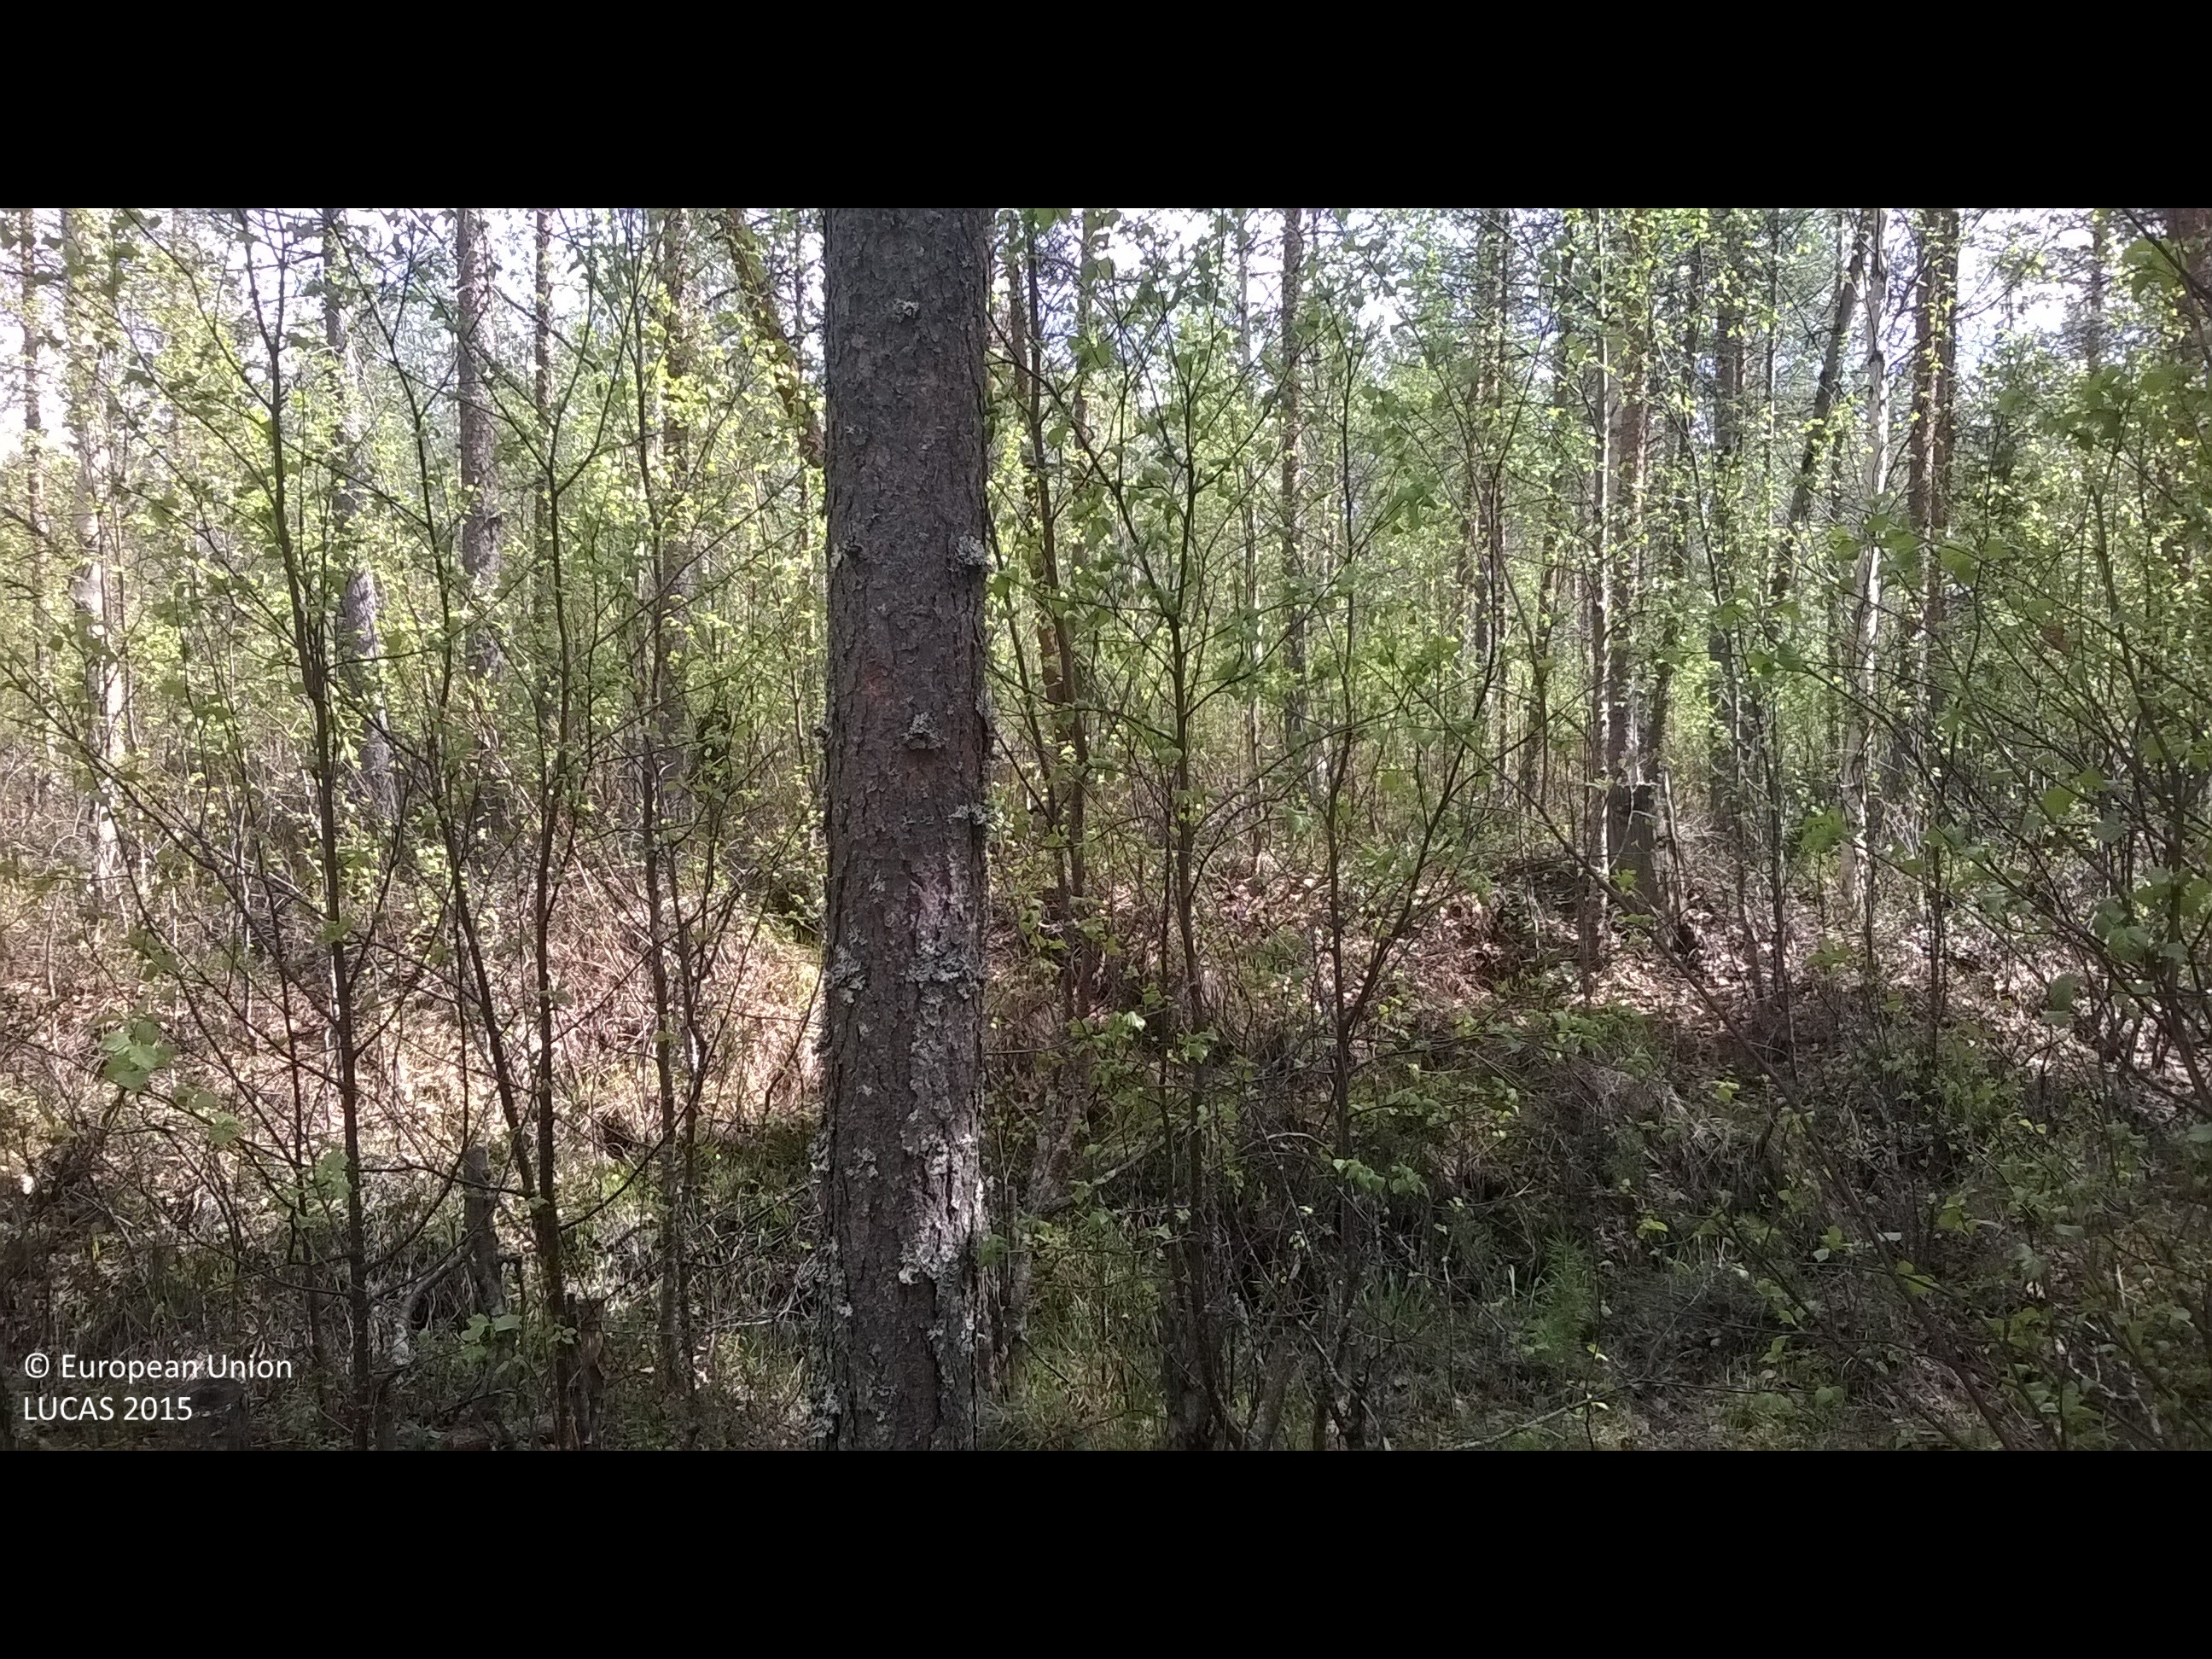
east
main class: Woodland
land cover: Pine dominated mixed woodland
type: boreal forest
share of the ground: > 75 %
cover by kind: broadleaved forest trees 60 %, coniferous forest trees 35 %, shrubs 5 %
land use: Forestry
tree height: > 5 m
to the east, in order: Pine dominated mixed woodland; Ditches and canals; Pine dominated mixed woodland; Electric lines; Pine dominated mixed woodland; Ditches and canals; Pine dominated mixed woodland; Ditches and canals; Pine dominated mixed woodland; Ditches and canals; Pine dominated mixed woodland; Ditches and canals; Pine dominated mixed woodland; Ditches and canals; Pine dominated mixed woodland
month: June
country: FI
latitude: 66.5738
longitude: 26.4723
